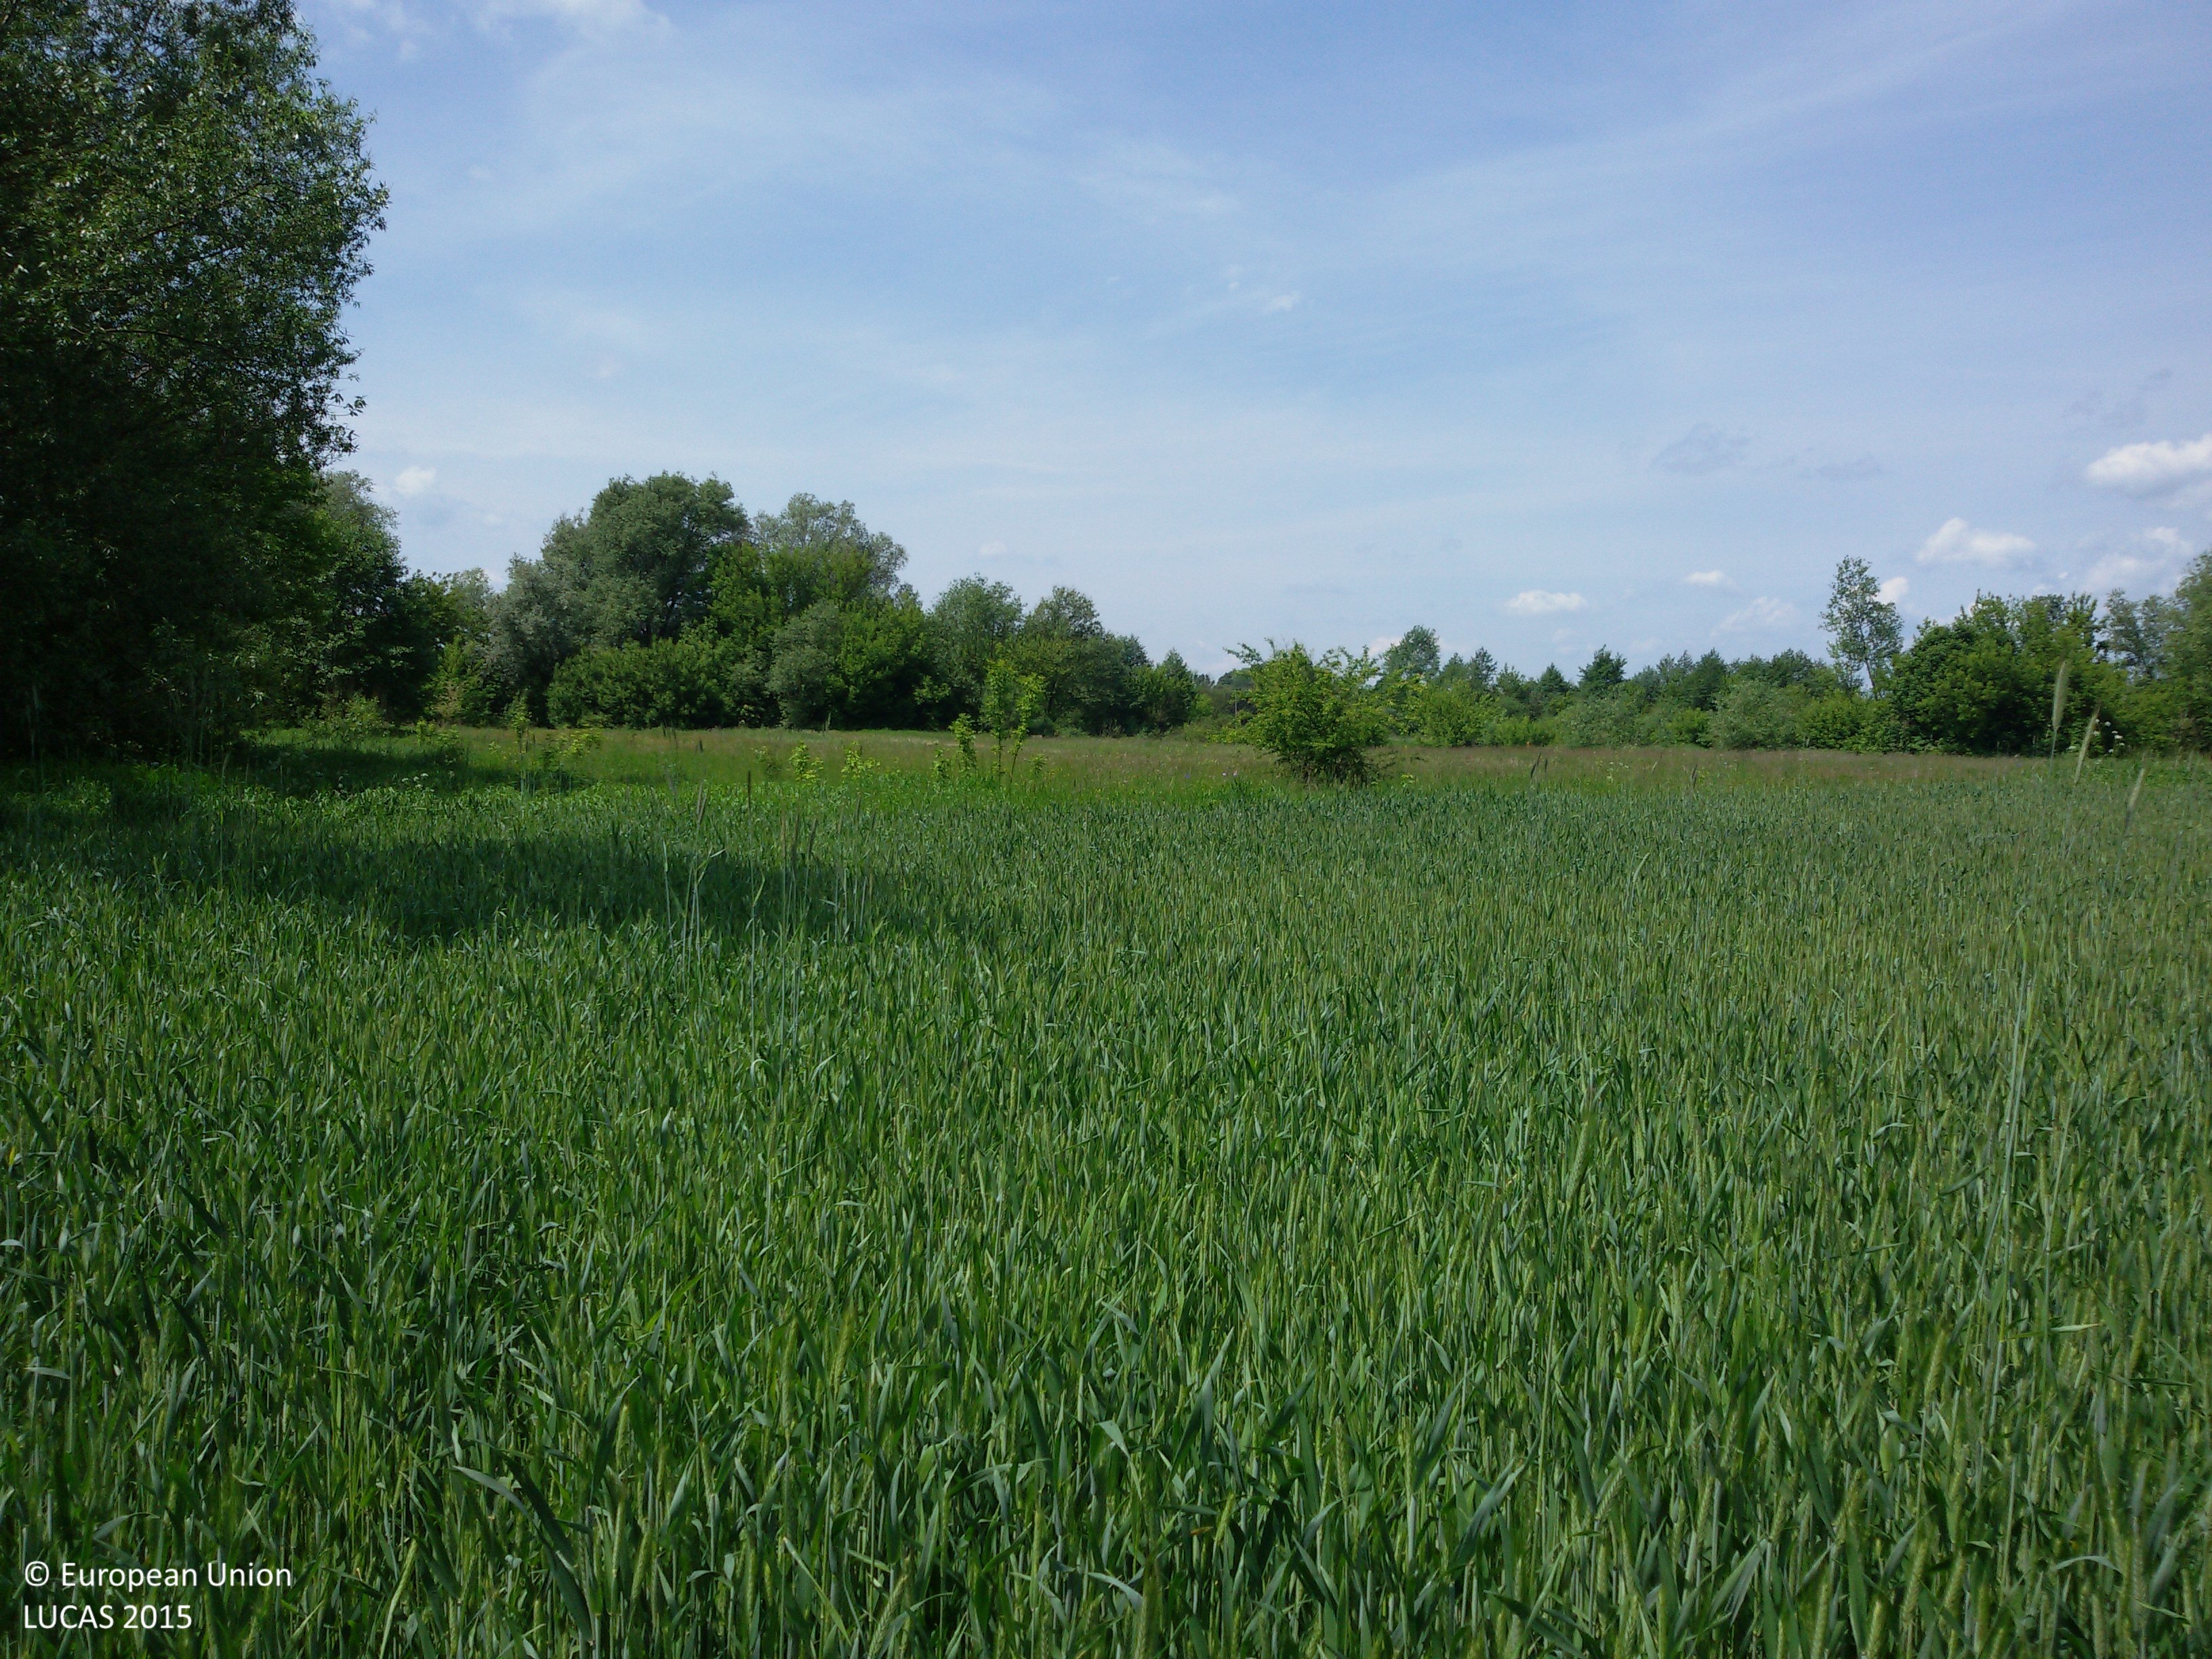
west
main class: Cropland
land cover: Rye
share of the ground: > 75 %
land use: Agriculture (excluding fallow land and kitchen gardens)
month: May
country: PL
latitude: 51.3584
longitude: 22.7514
